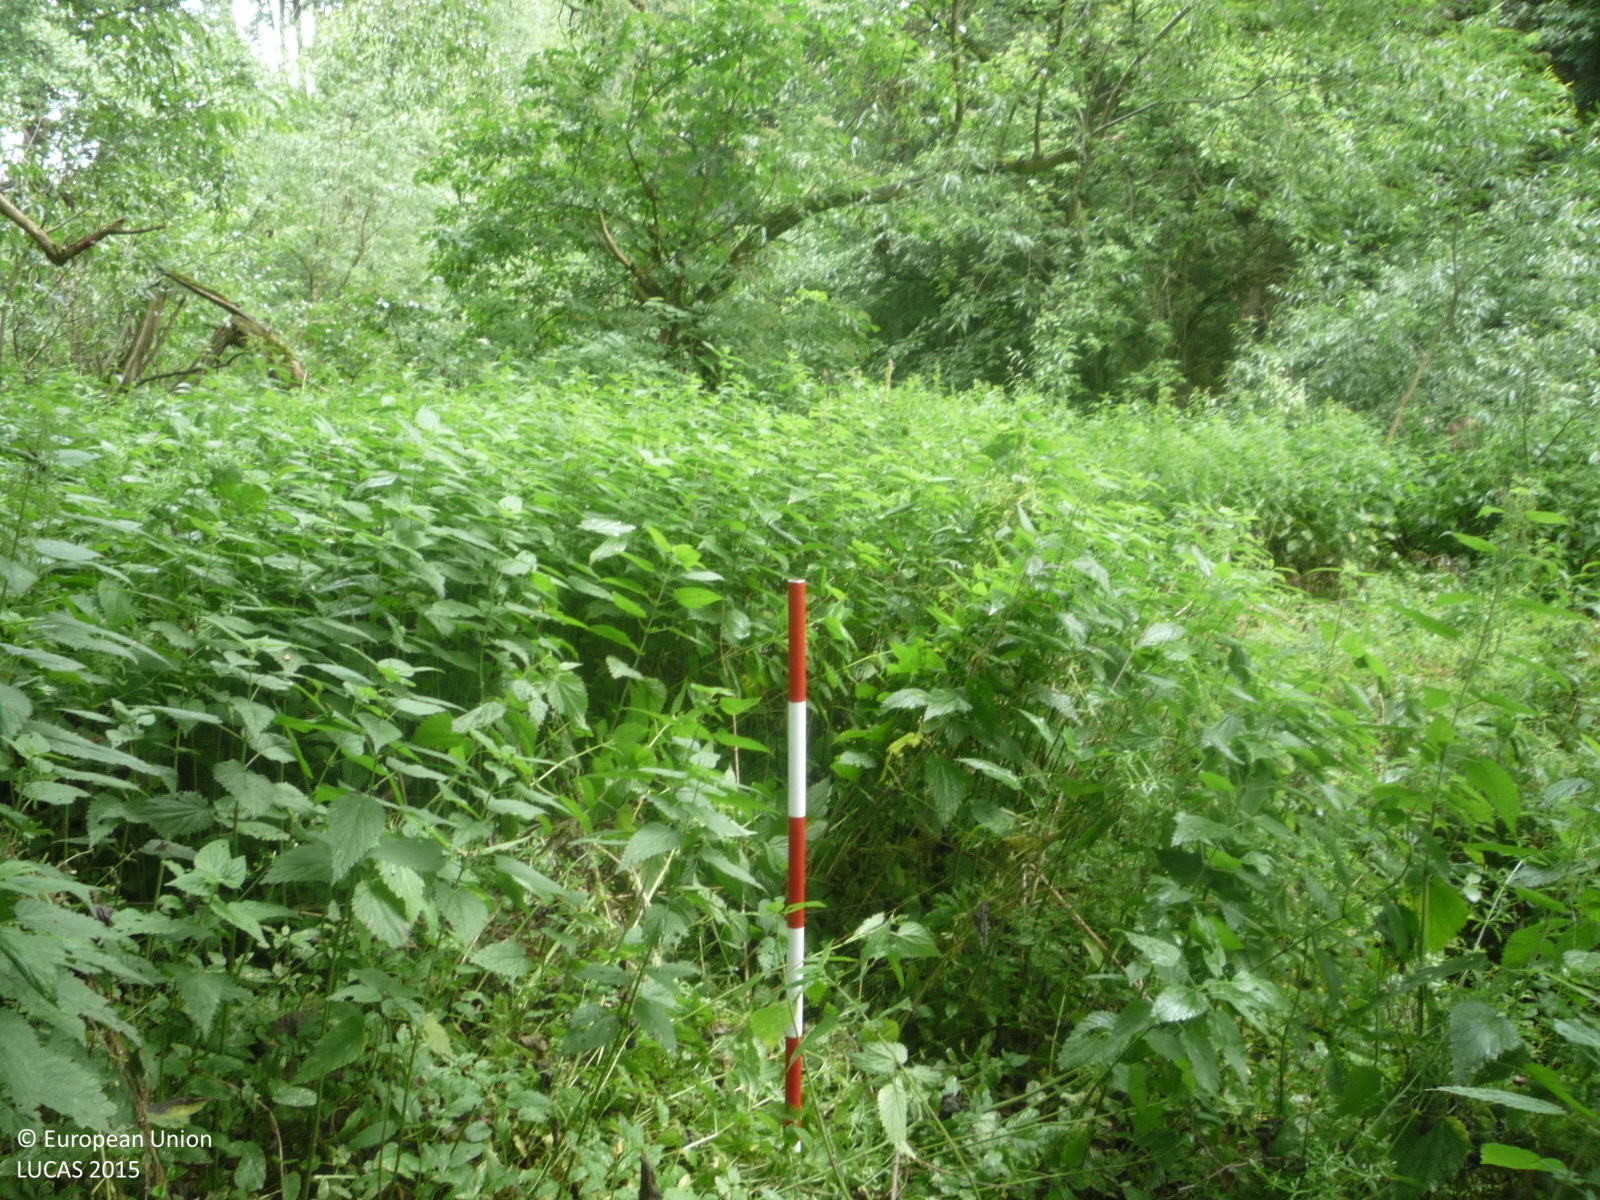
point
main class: Woodland
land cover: Broadleaved woodland
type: floodplain forest
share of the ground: > 75 %
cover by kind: broadleaved forest trees 50 %, herbaceous plants 40 %, shrubs 10 %
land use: Semi-natural and natural areas not in use
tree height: > 5 m
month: July
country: CZ
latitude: 50.4393
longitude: 15.6790
